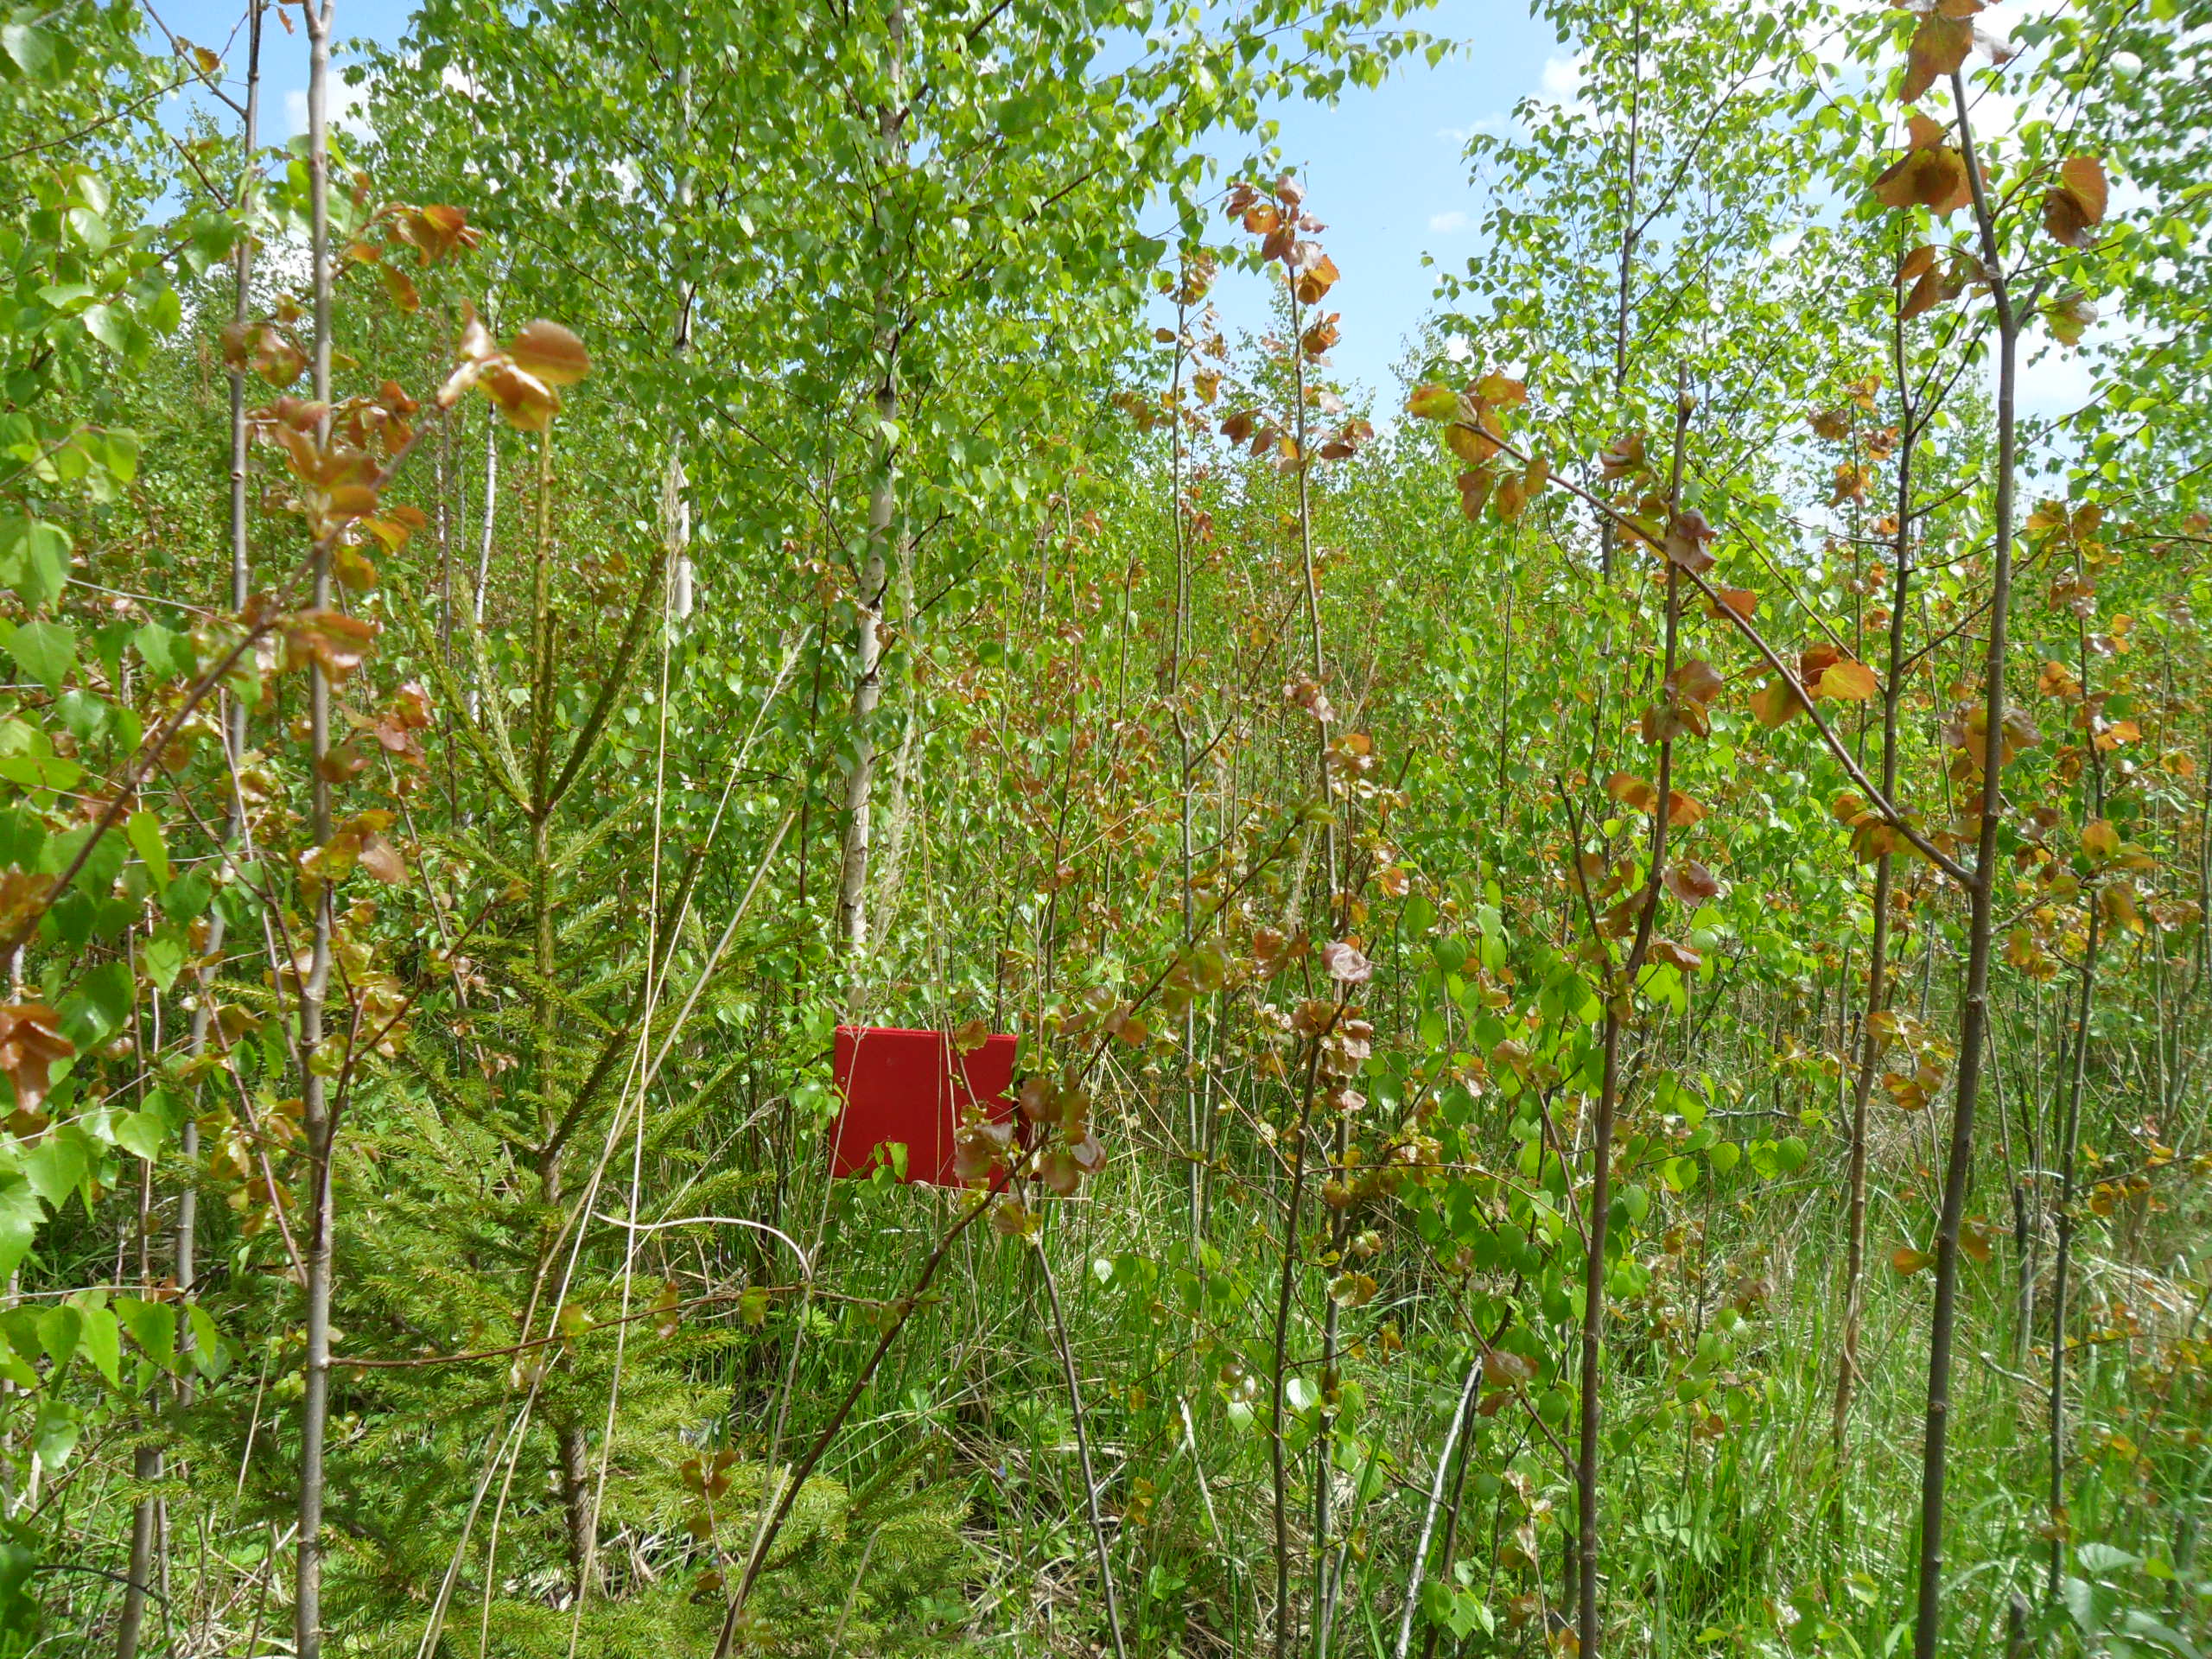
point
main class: Woodland
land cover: Broadleaved woodland
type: non-riverine alder, birch or aspen forest
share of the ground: > 75 %
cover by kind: broadleaved forest trees 80 %, coniferous forest trees 20 %
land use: Forestry
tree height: < 5 m
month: May
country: LV
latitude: 57.2916
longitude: 22.4477
